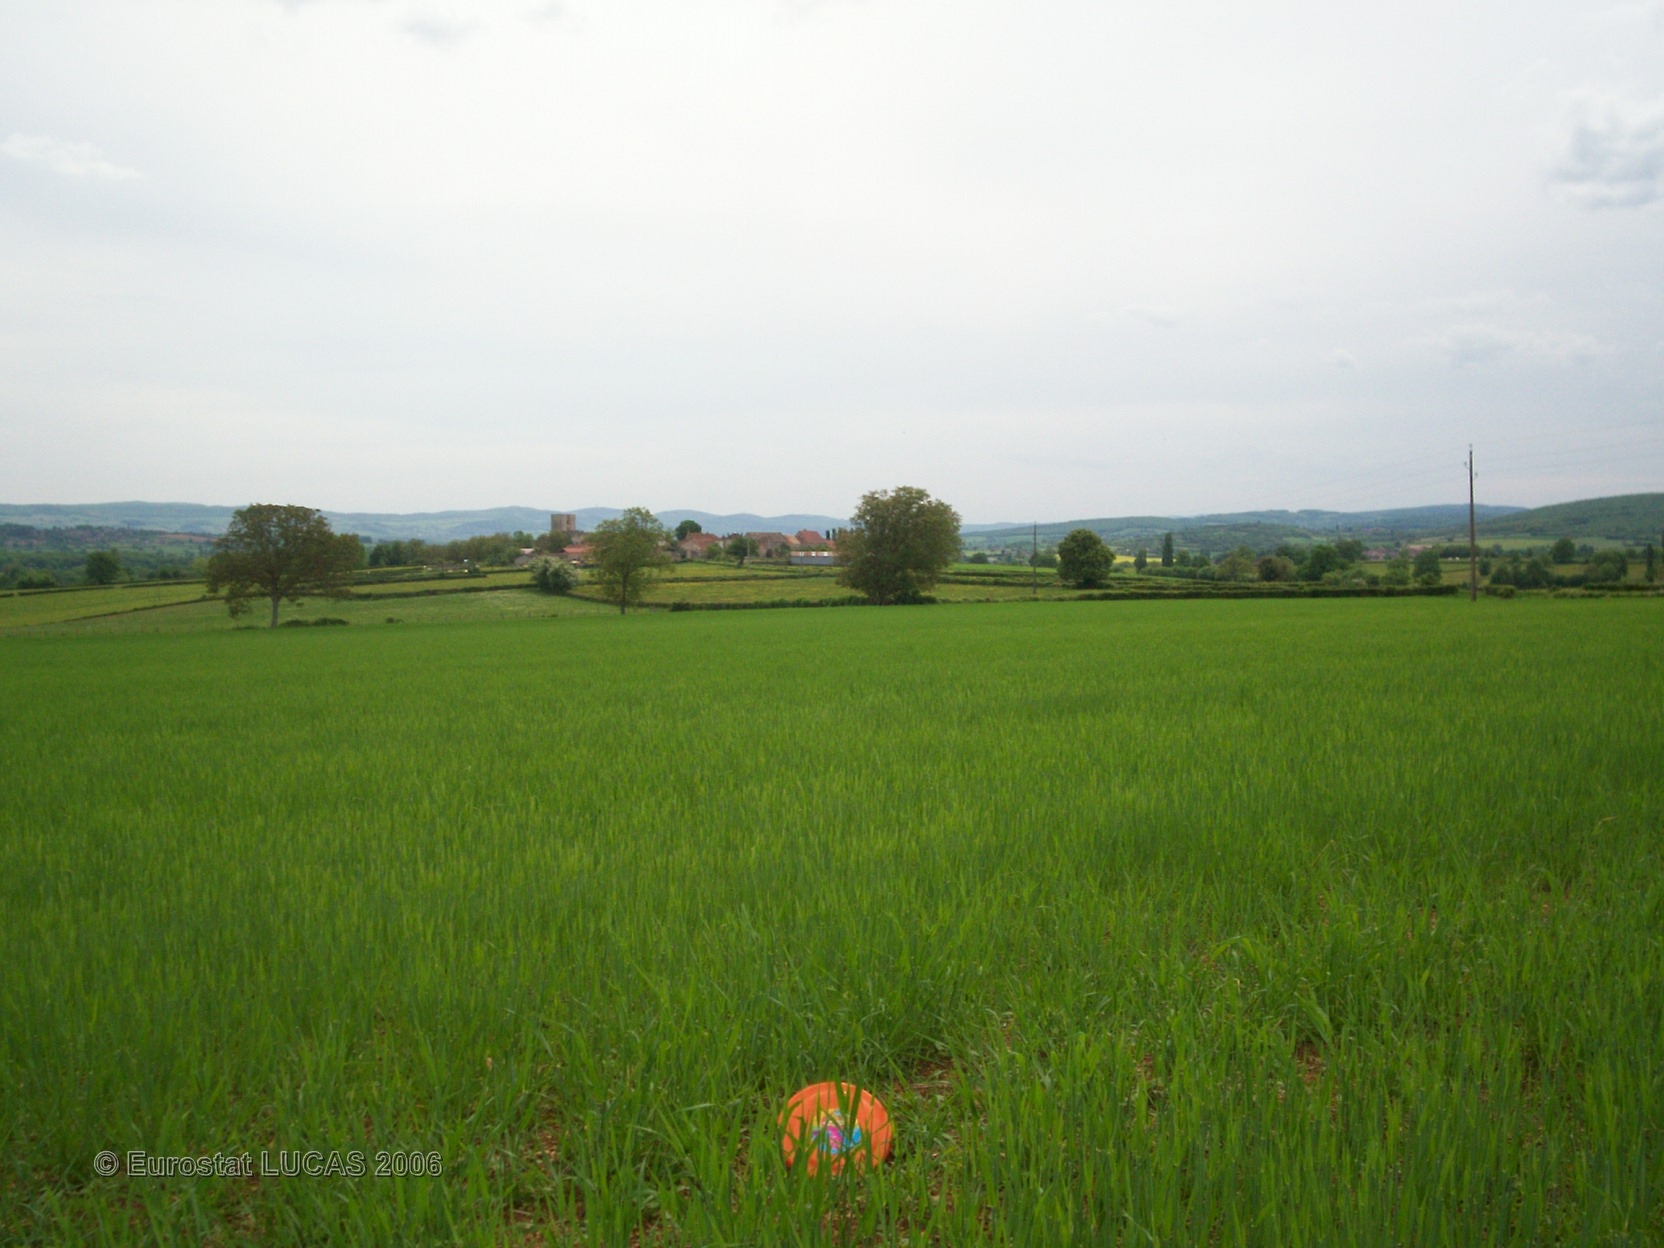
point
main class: Cropland
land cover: Barley
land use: Agriculture (excluding fallow land and kitchen gardens)
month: May
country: FR
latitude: 46.5598
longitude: 4.6401
